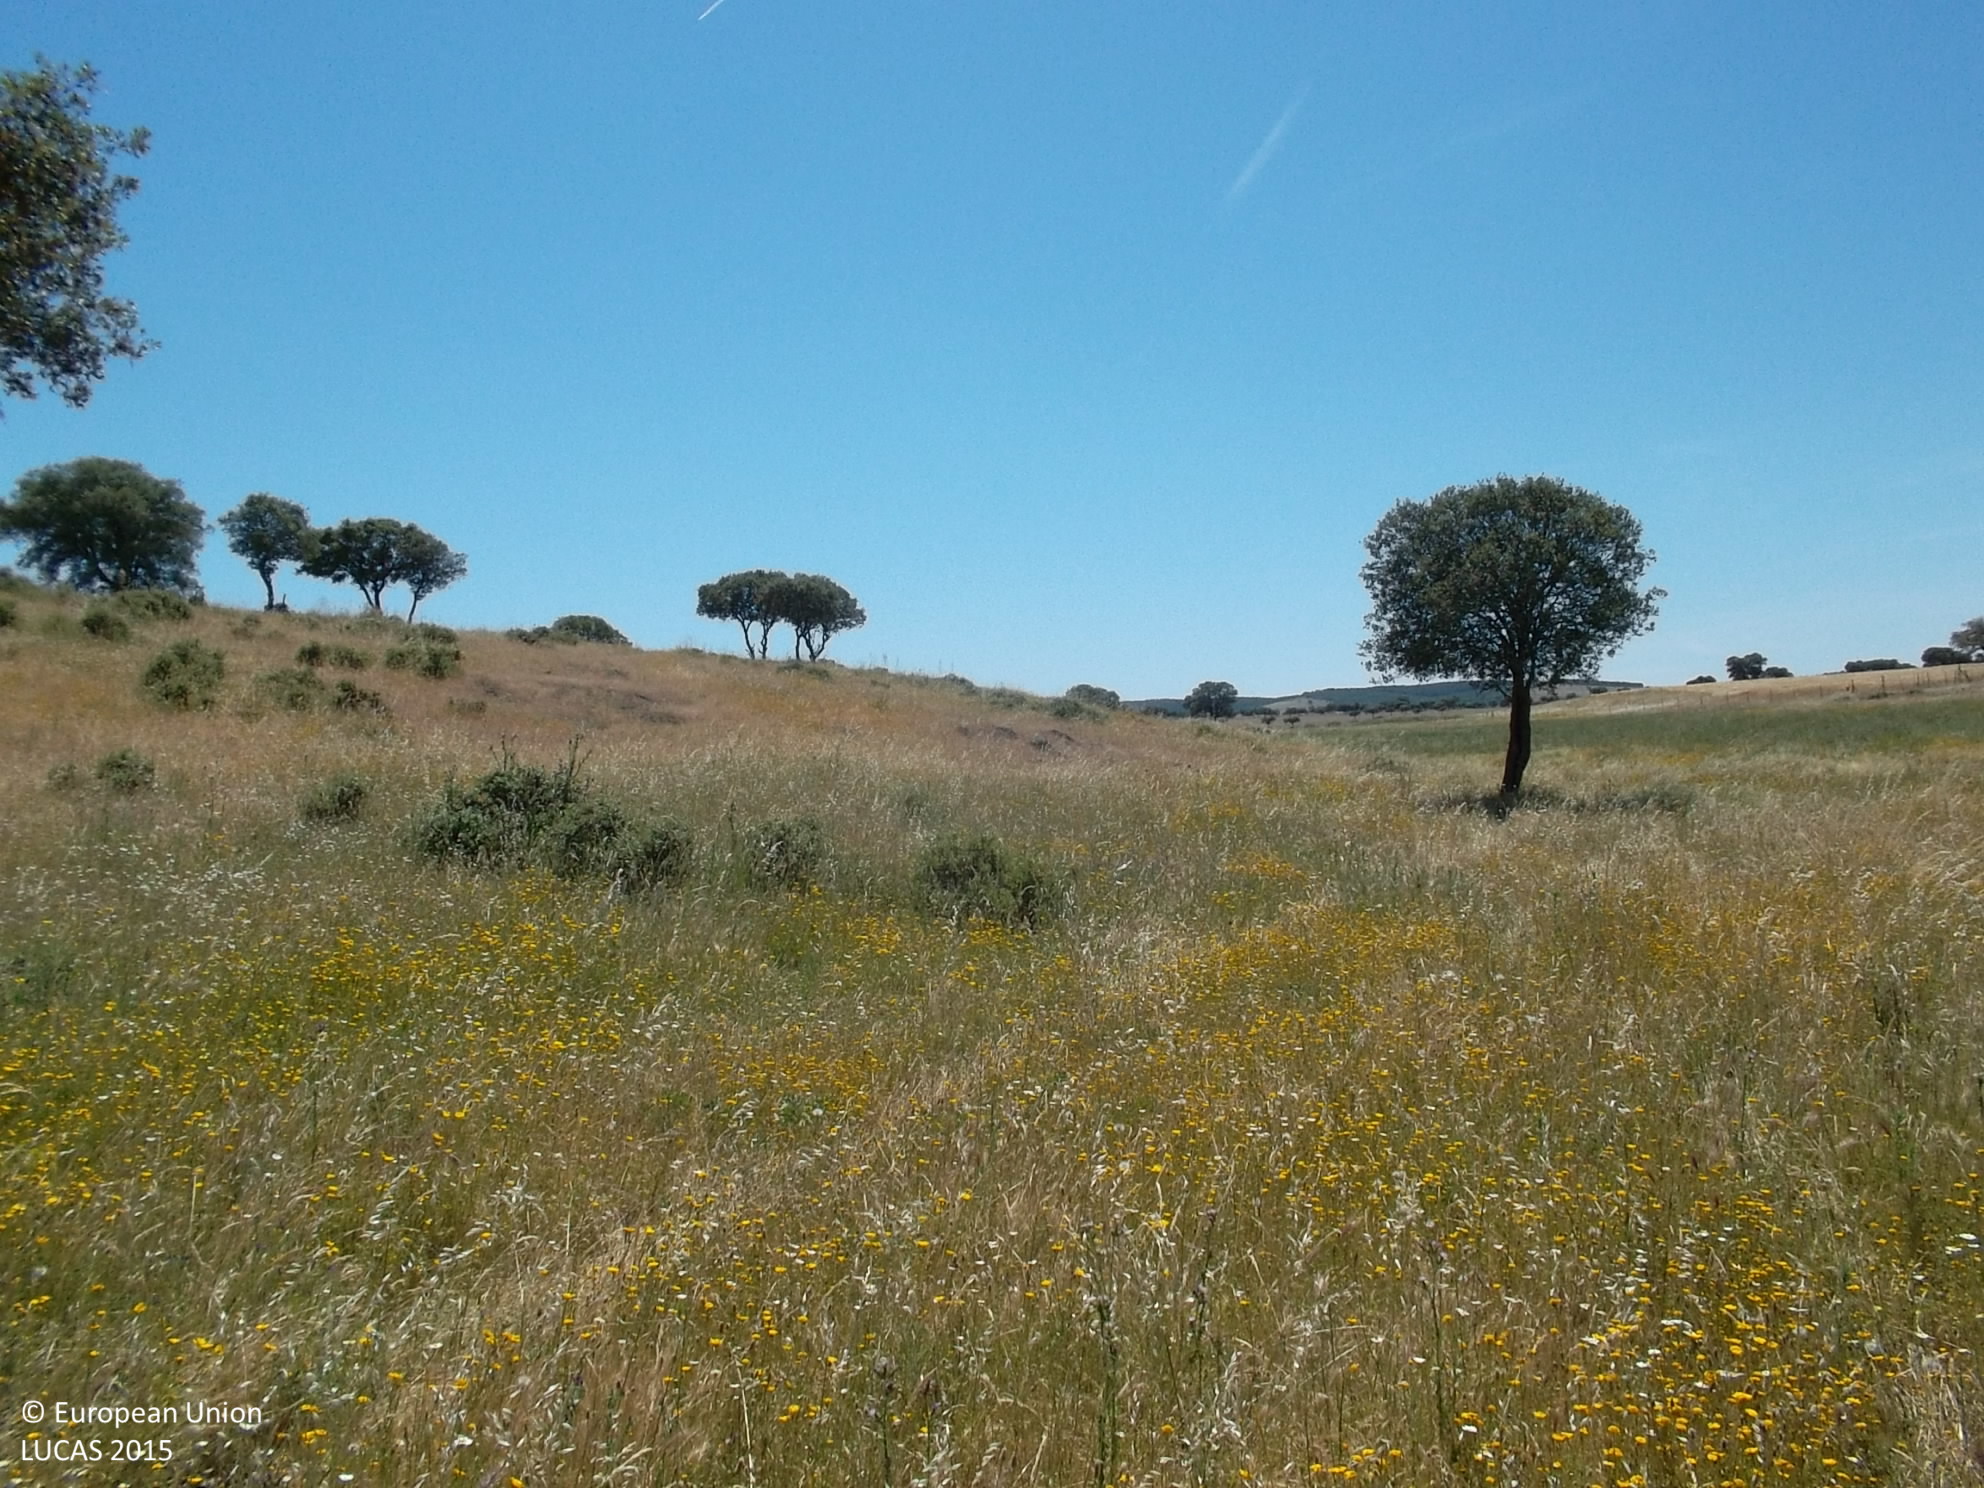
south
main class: Grassland
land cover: Grassland with sparse tree/shrub cover
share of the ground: > 75 %
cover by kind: herbaceous plants 95 %, broadleaved forest trees 5 %
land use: Agriculture (excluding fallow land and kitchen gardens)
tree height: > 5 m
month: May
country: ES
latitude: 38.8621
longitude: -4.4423
